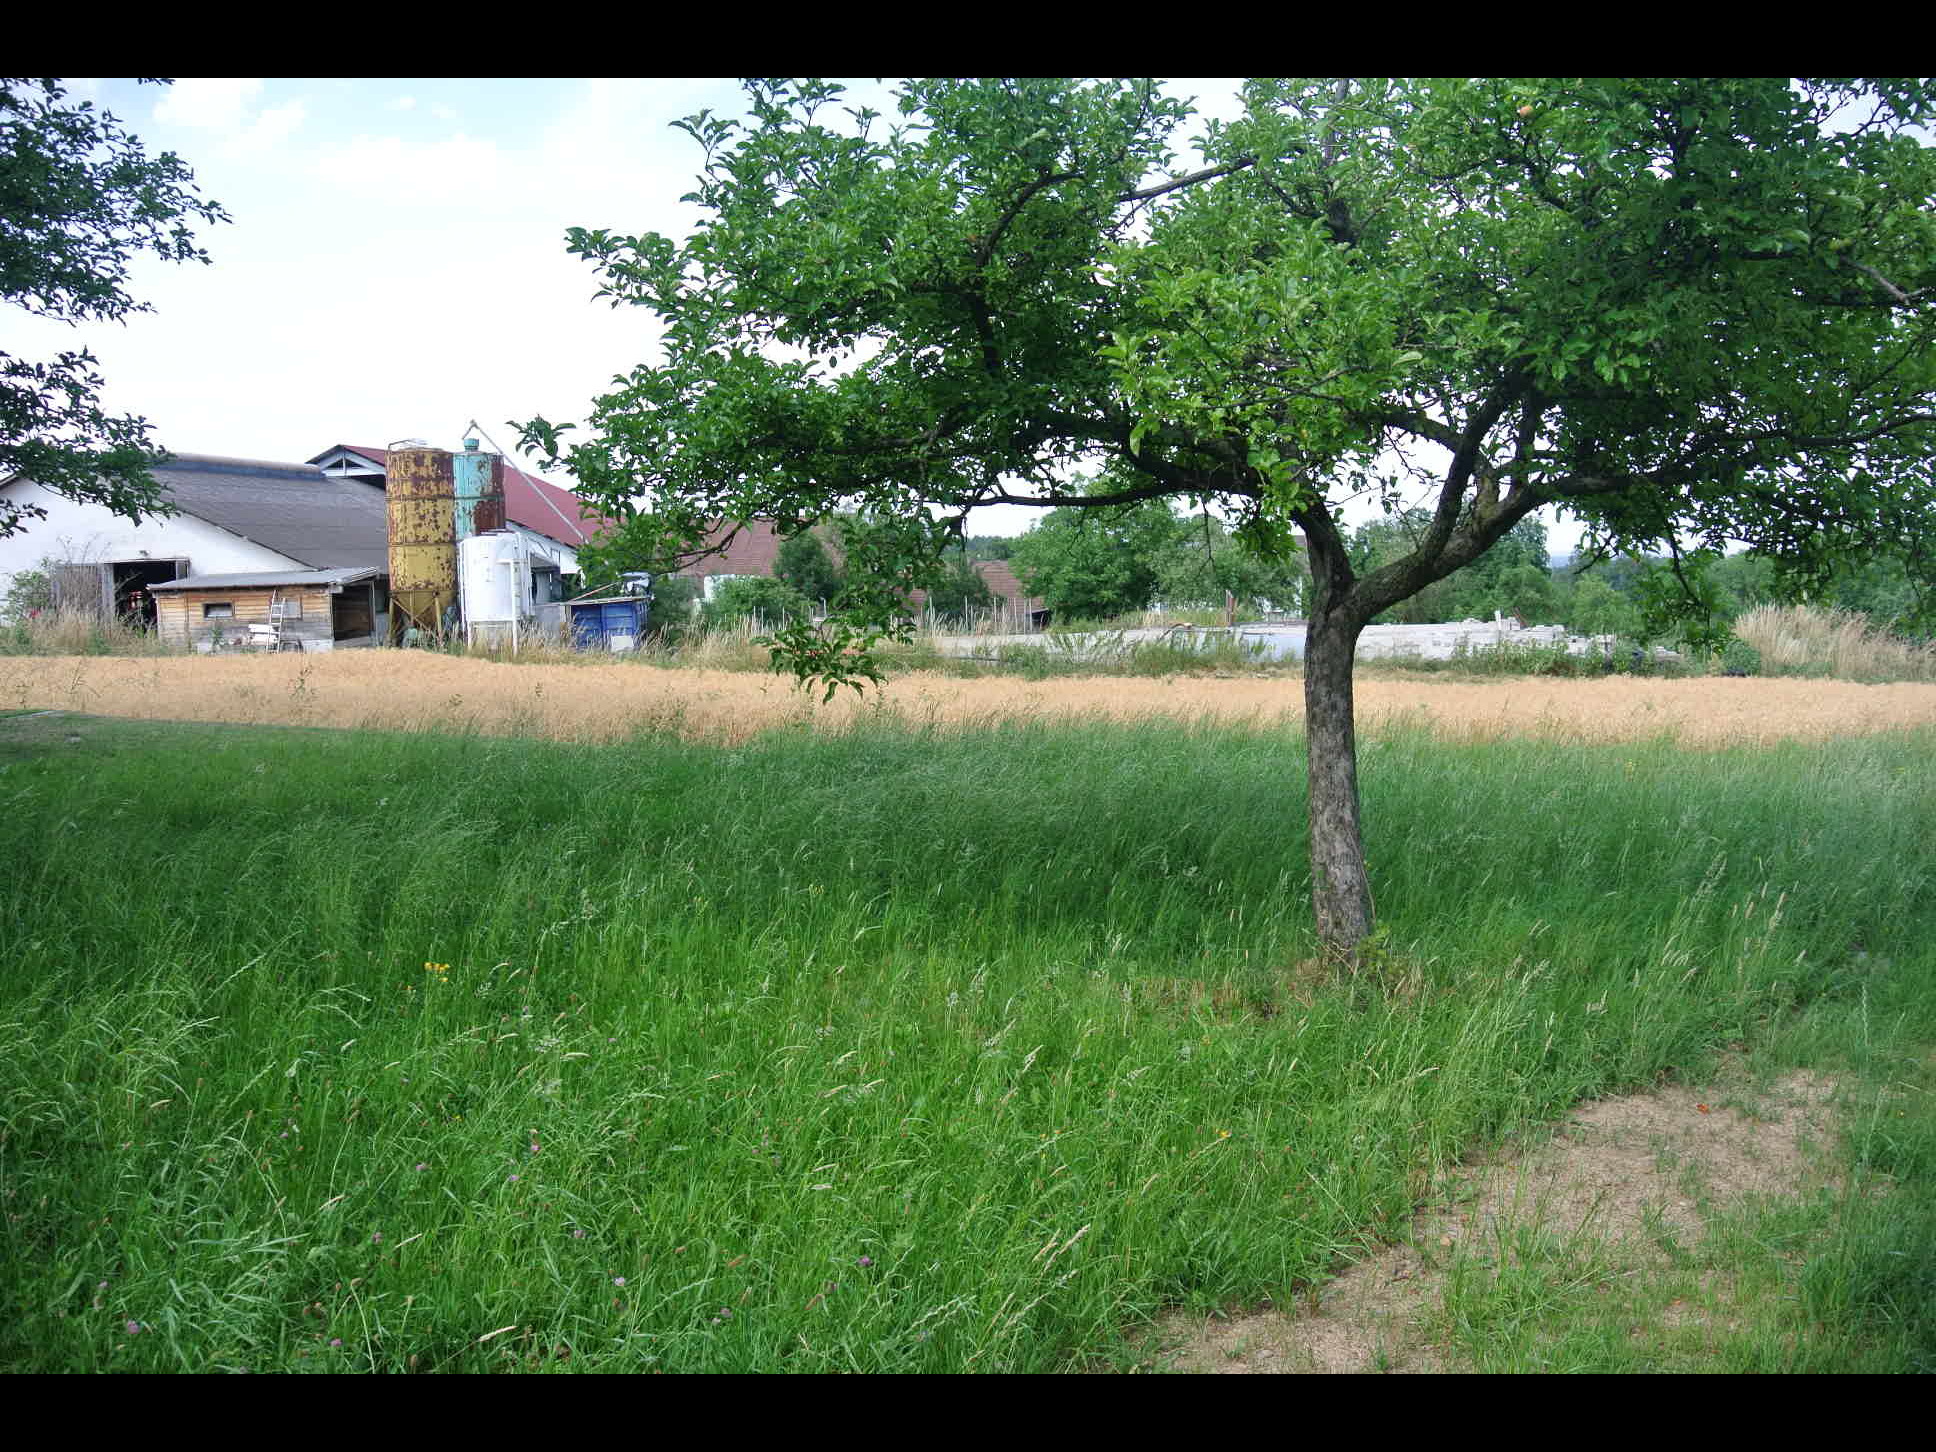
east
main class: Cropland
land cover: Apple fruit
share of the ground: > 75 %
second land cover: Spontaneously vegetated surfaces
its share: > 75 %
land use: Kitchen garden
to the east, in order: Apple fruit; Spontaneously vegetated surfaces; Apple fruit; Maize; Soya; Maize
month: July
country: AT
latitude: 47.6777
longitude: 16.0634
